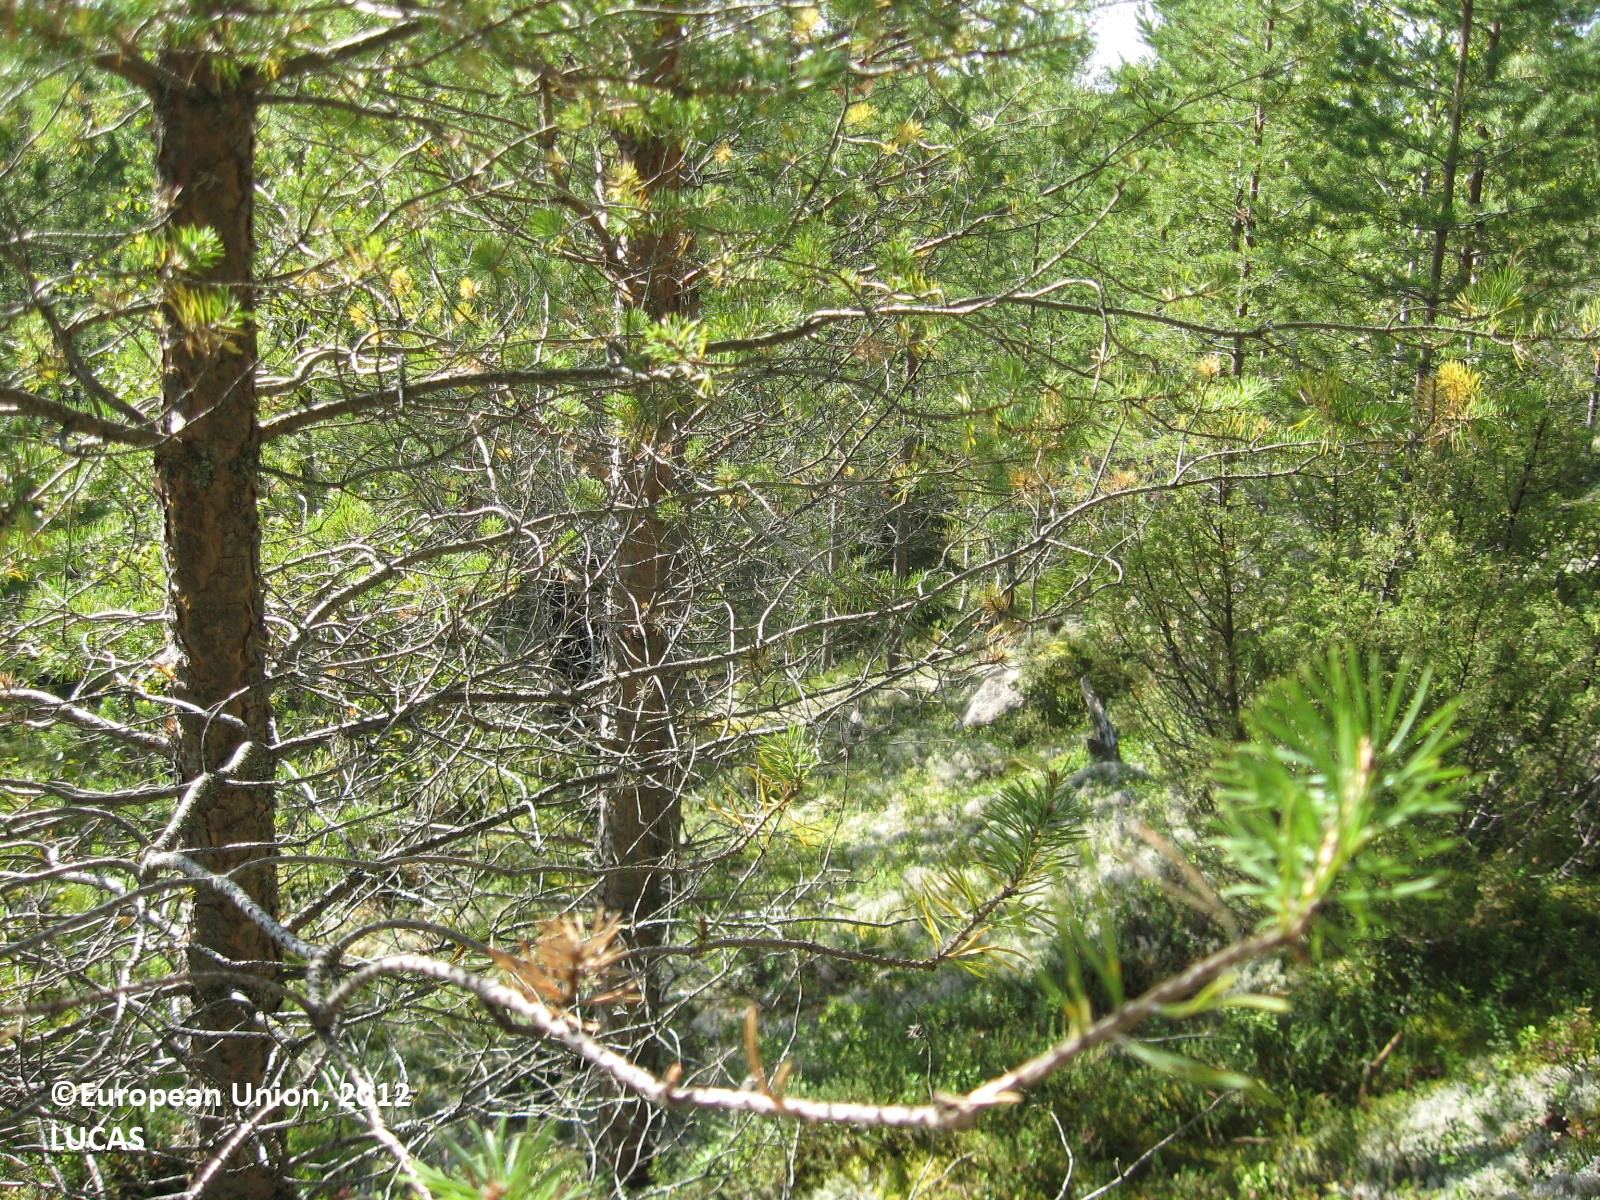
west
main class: Woodland
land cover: Pine dominated coniferous woodland
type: boreal forest
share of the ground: > 75 %
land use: Forestry
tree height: > 5 m
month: August
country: FI
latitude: 63.6798
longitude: 29.7420
